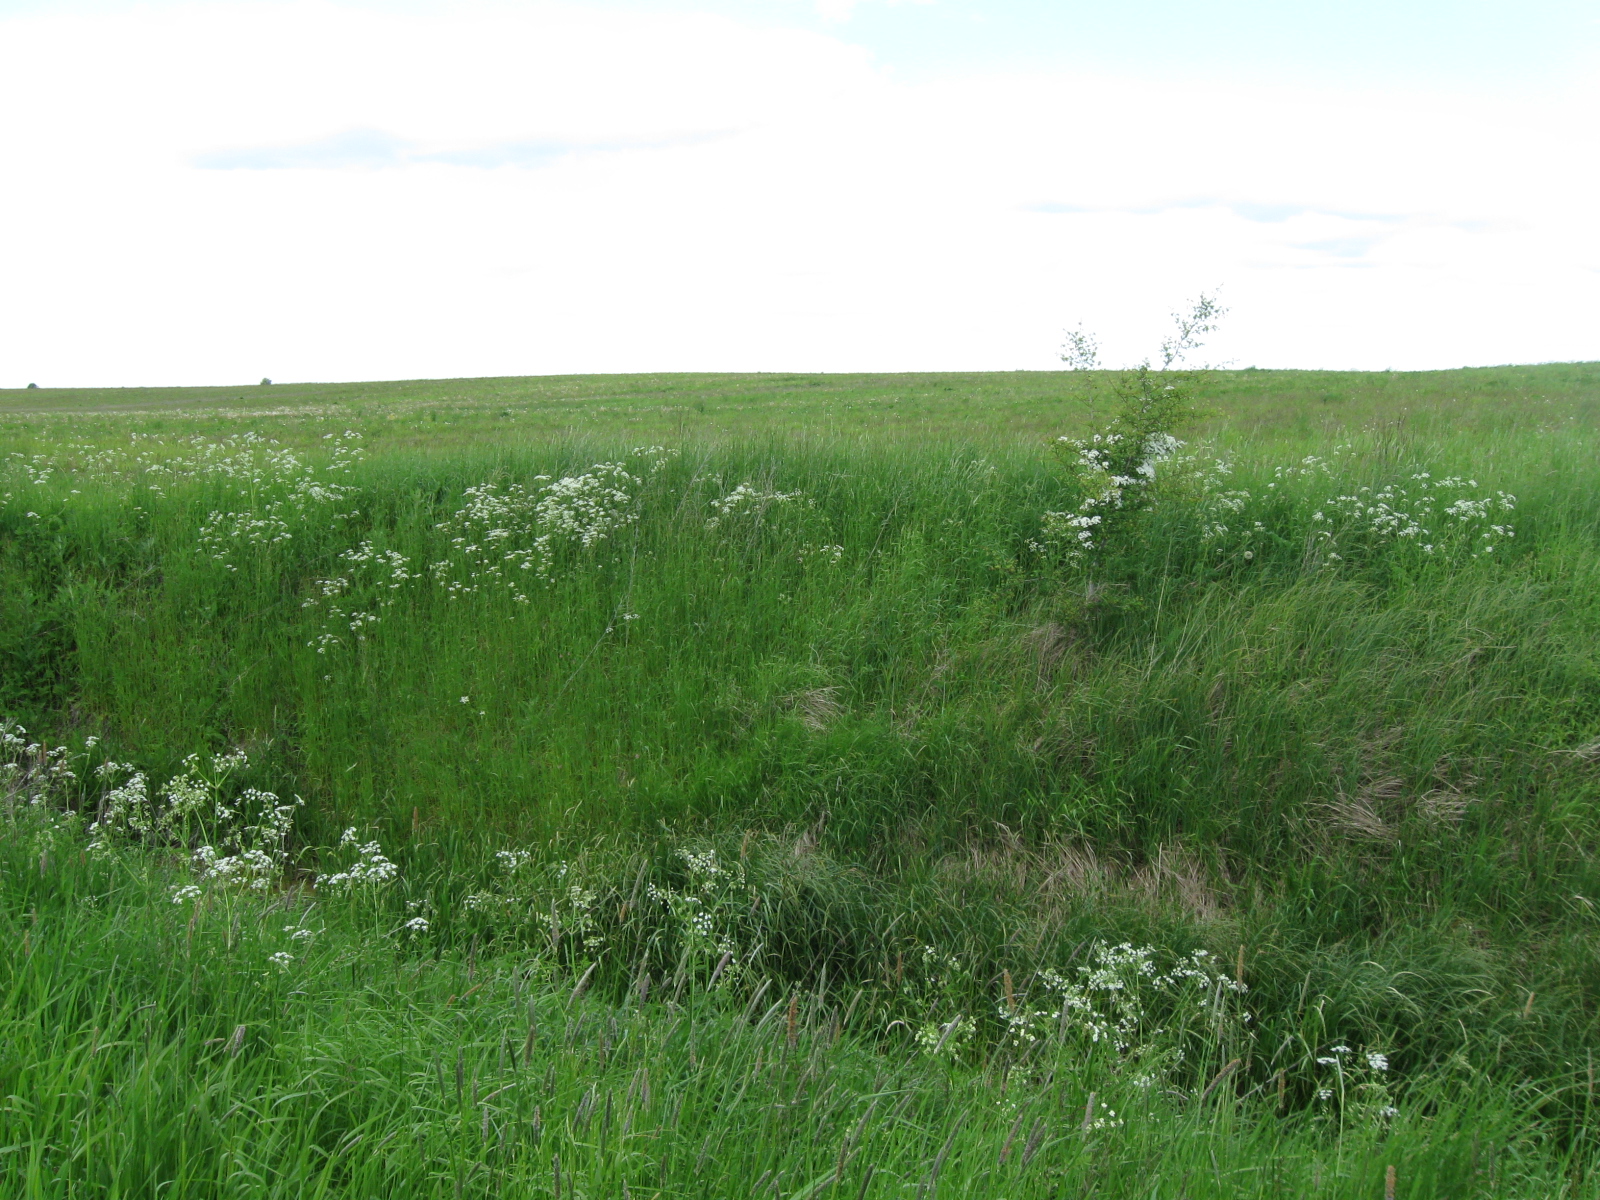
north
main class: Grassland
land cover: Grassland without tree/shrub cover
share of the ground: > 75 %
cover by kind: herbaceous plants 100 %
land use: Agriculture (excluding fallow land and kitchen gardens)
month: May
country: LT
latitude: 54.6894
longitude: 22.7734
